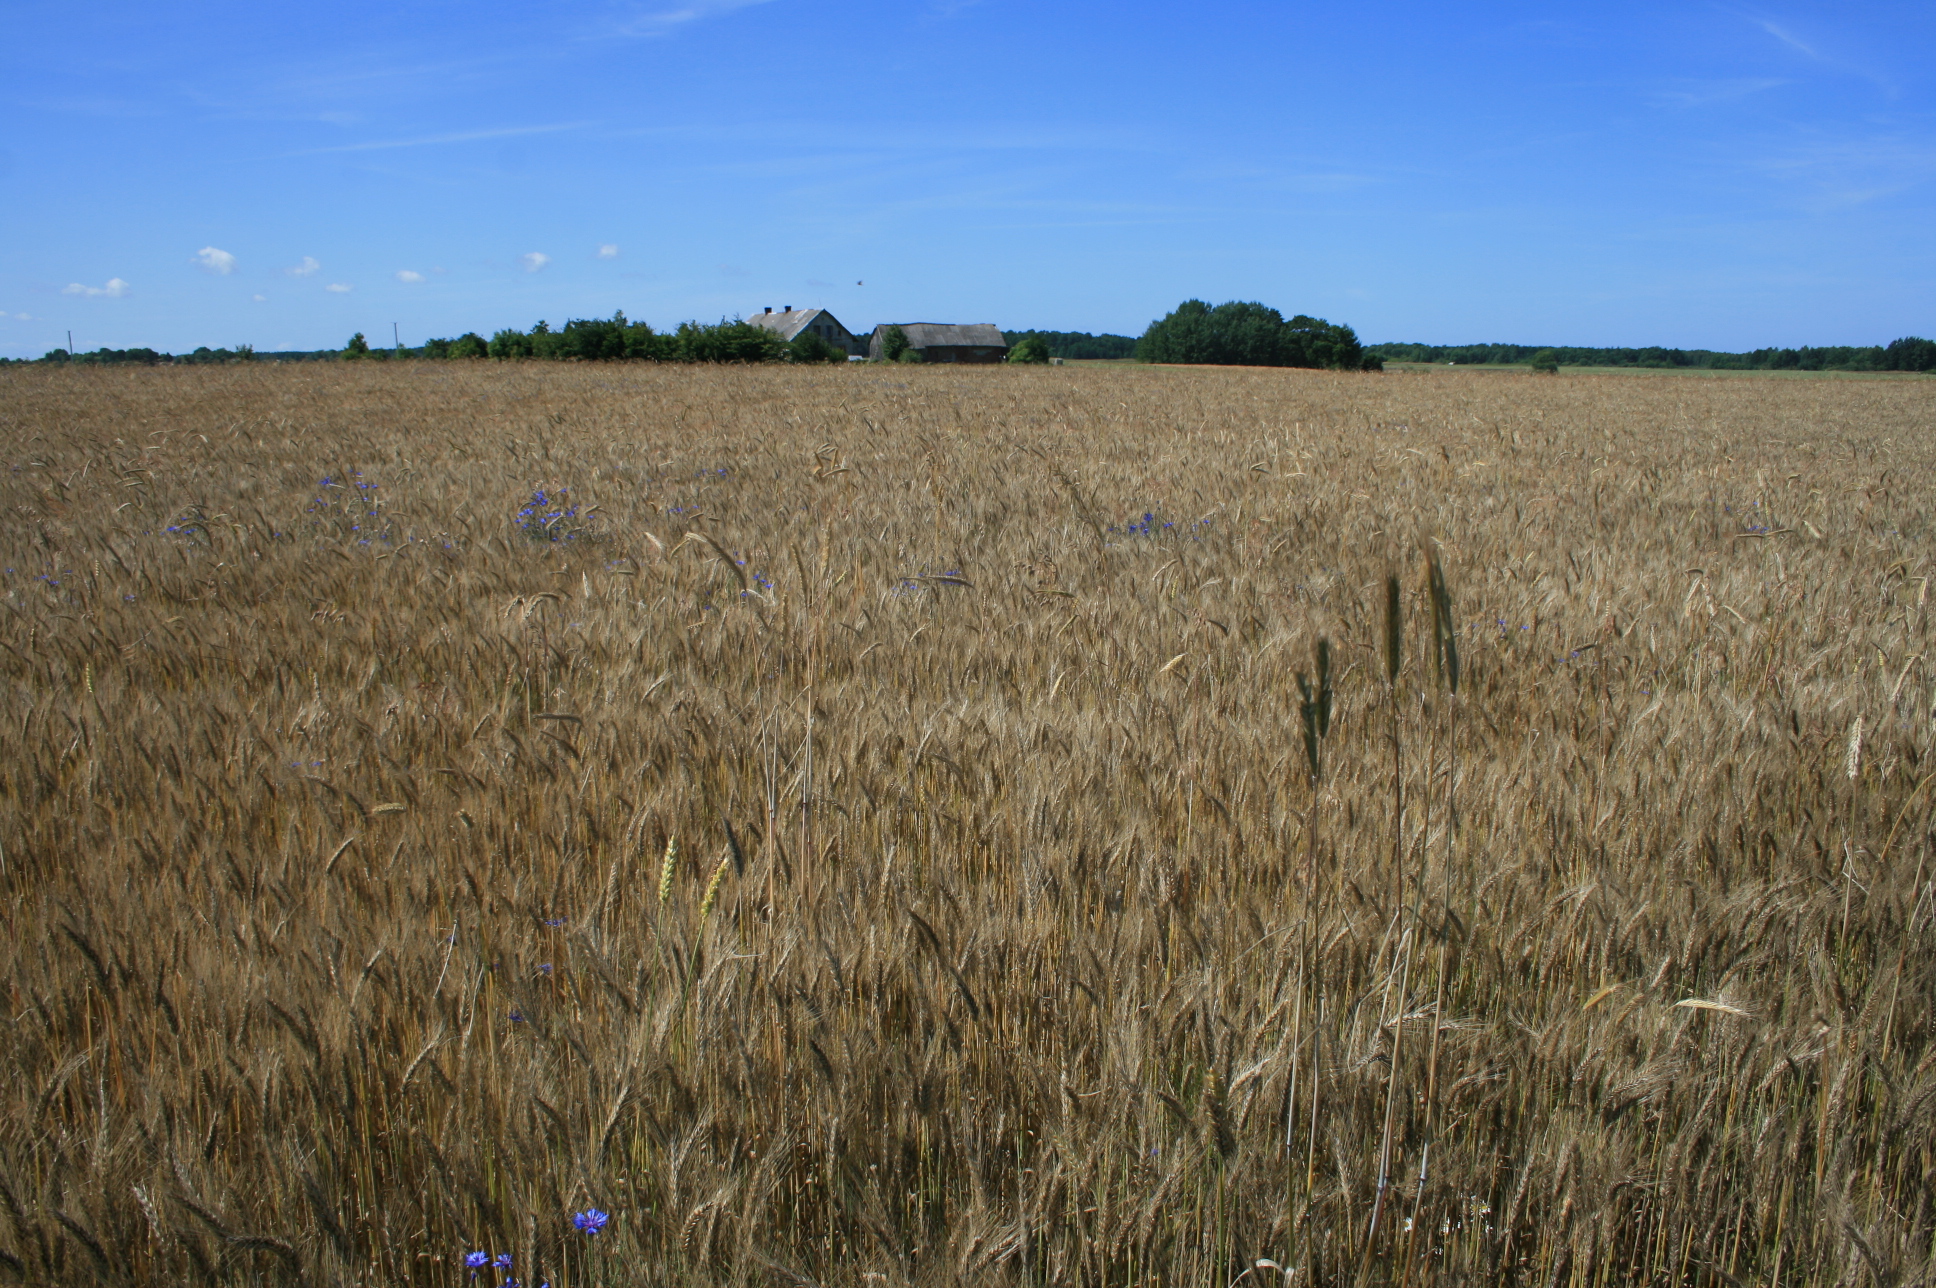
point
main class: Cropland
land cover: Triticale
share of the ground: > 75 %
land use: Agriculture (excluding fallow land and kitchen gardens)
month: July
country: LT
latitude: 55.4669
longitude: 21.3213
